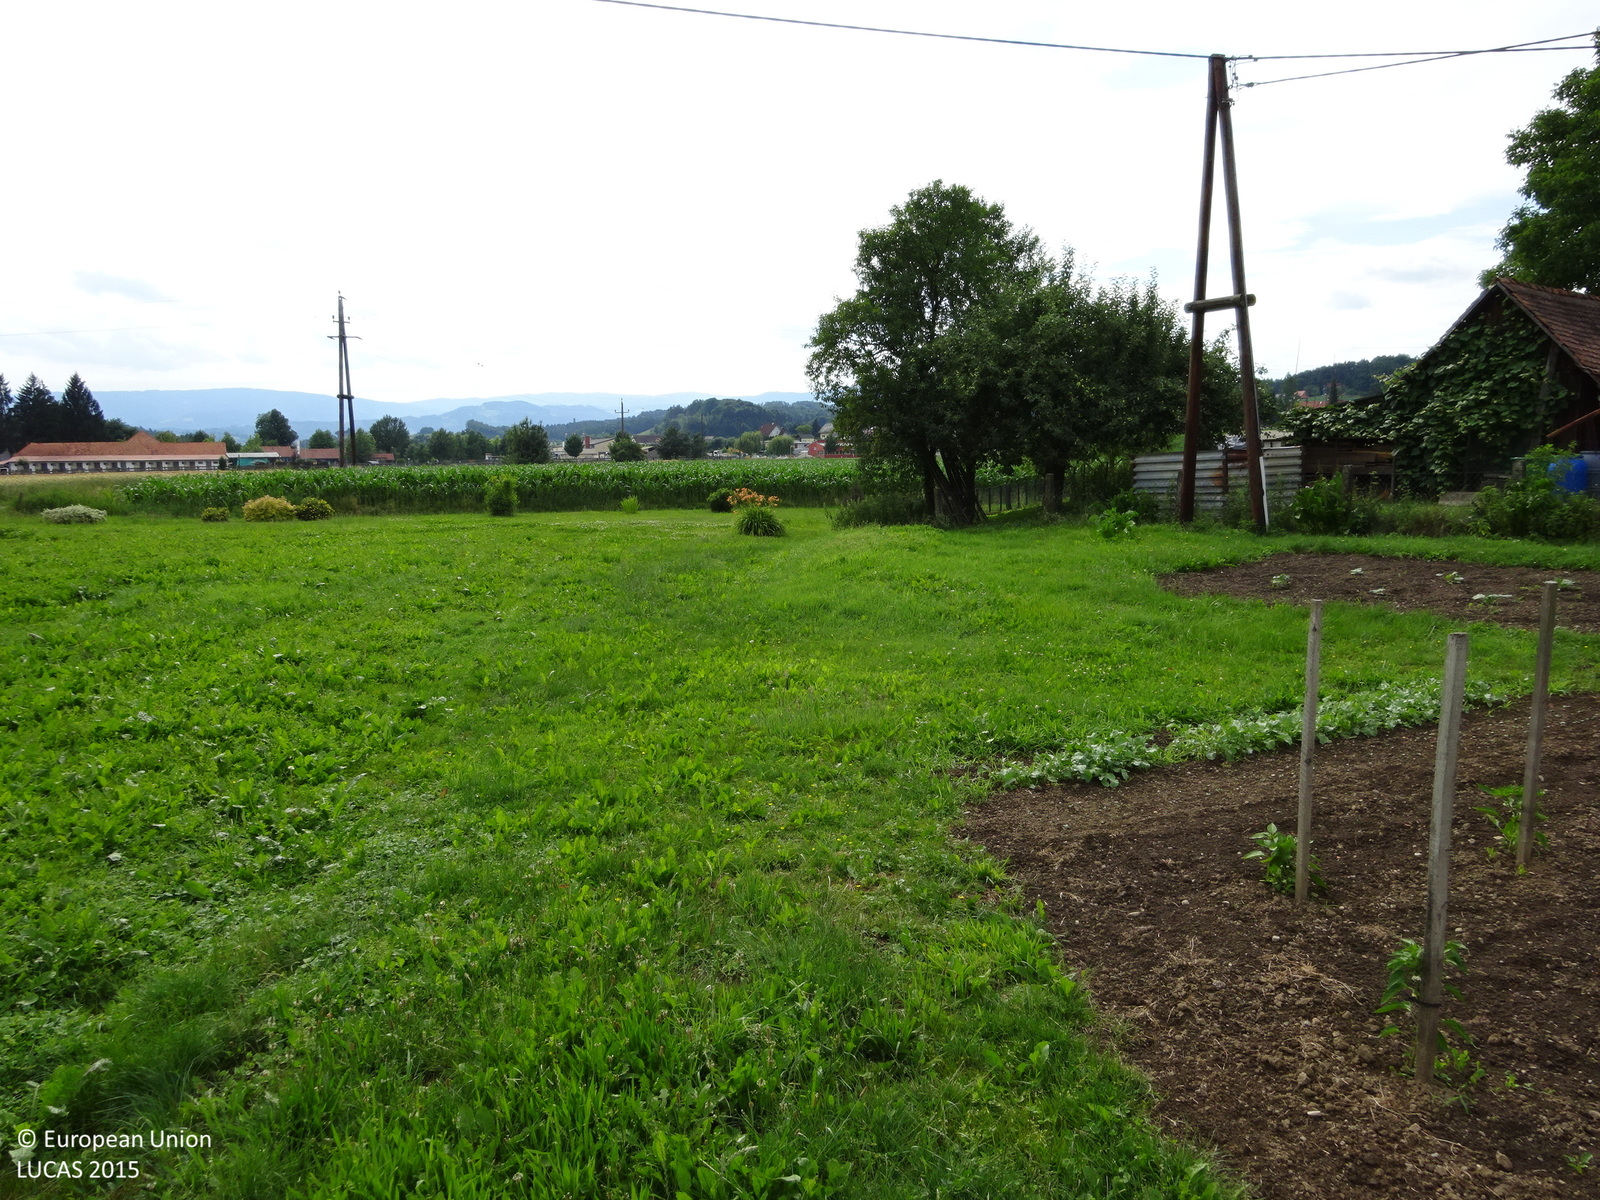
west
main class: Cropland
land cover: Other fresh vegetables
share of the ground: 25 - 50 %
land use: Kitchen garden
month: June
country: AT
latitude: 46.7253
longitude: 15.2980
